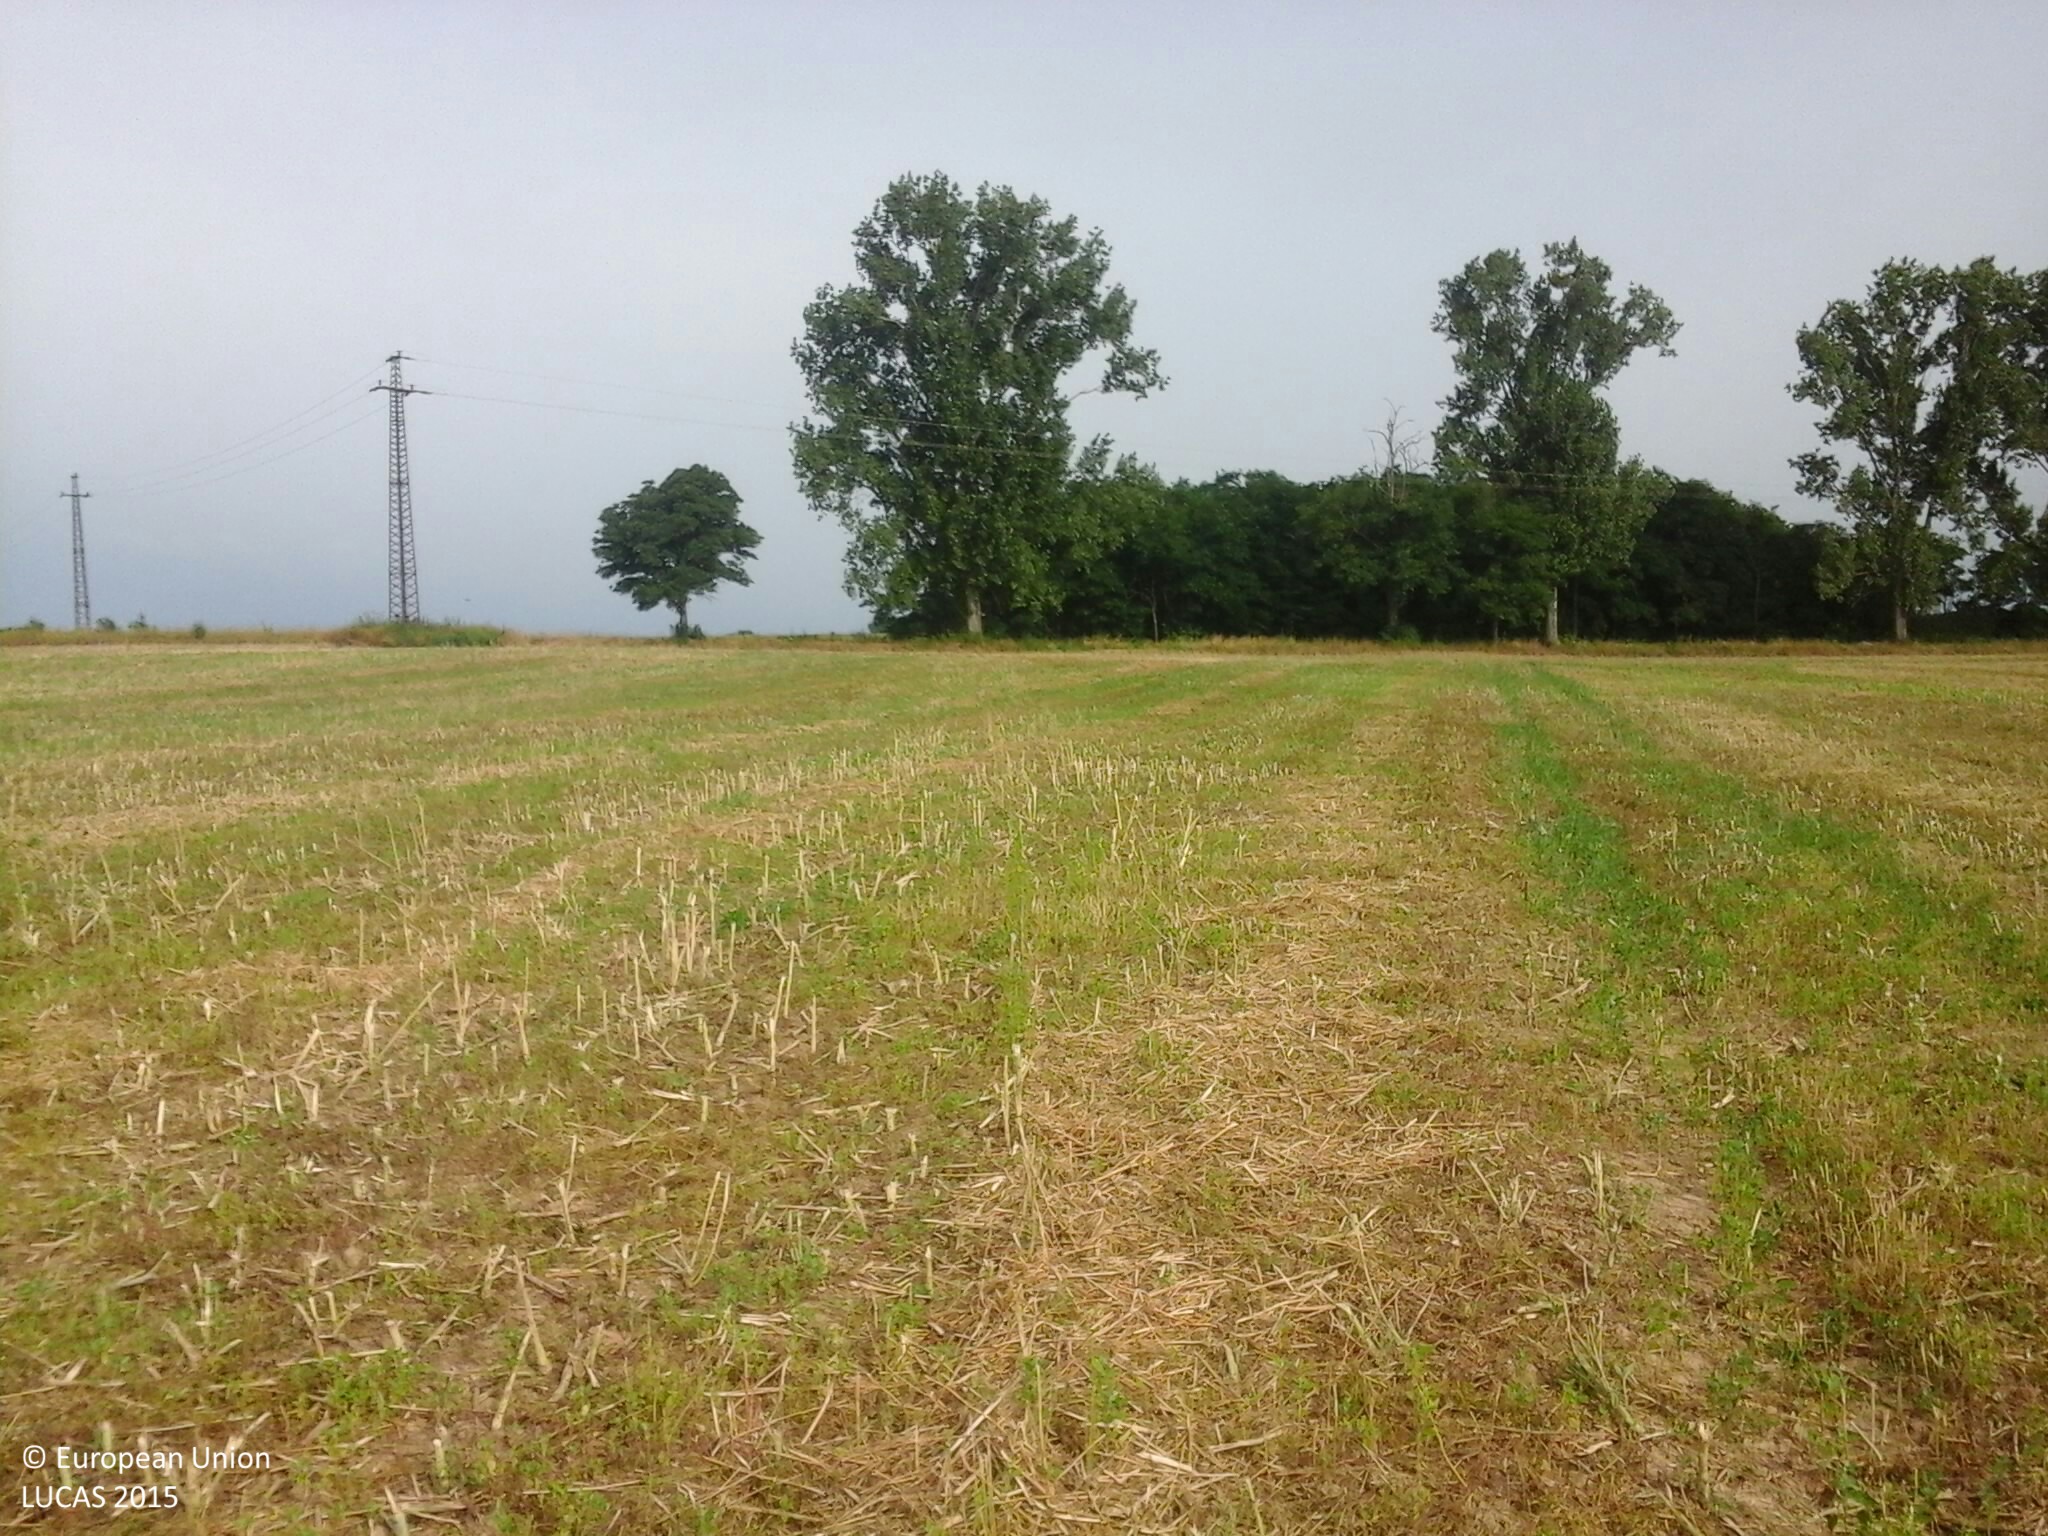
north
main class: Cropland
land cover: Rape and turnip rape
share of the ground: 10 - 25 %
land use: Agriculture (excluding fallow land and kitchen gardens)
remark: Harvested field
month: July
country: HU
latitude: 47.1860
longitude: 17.3041
